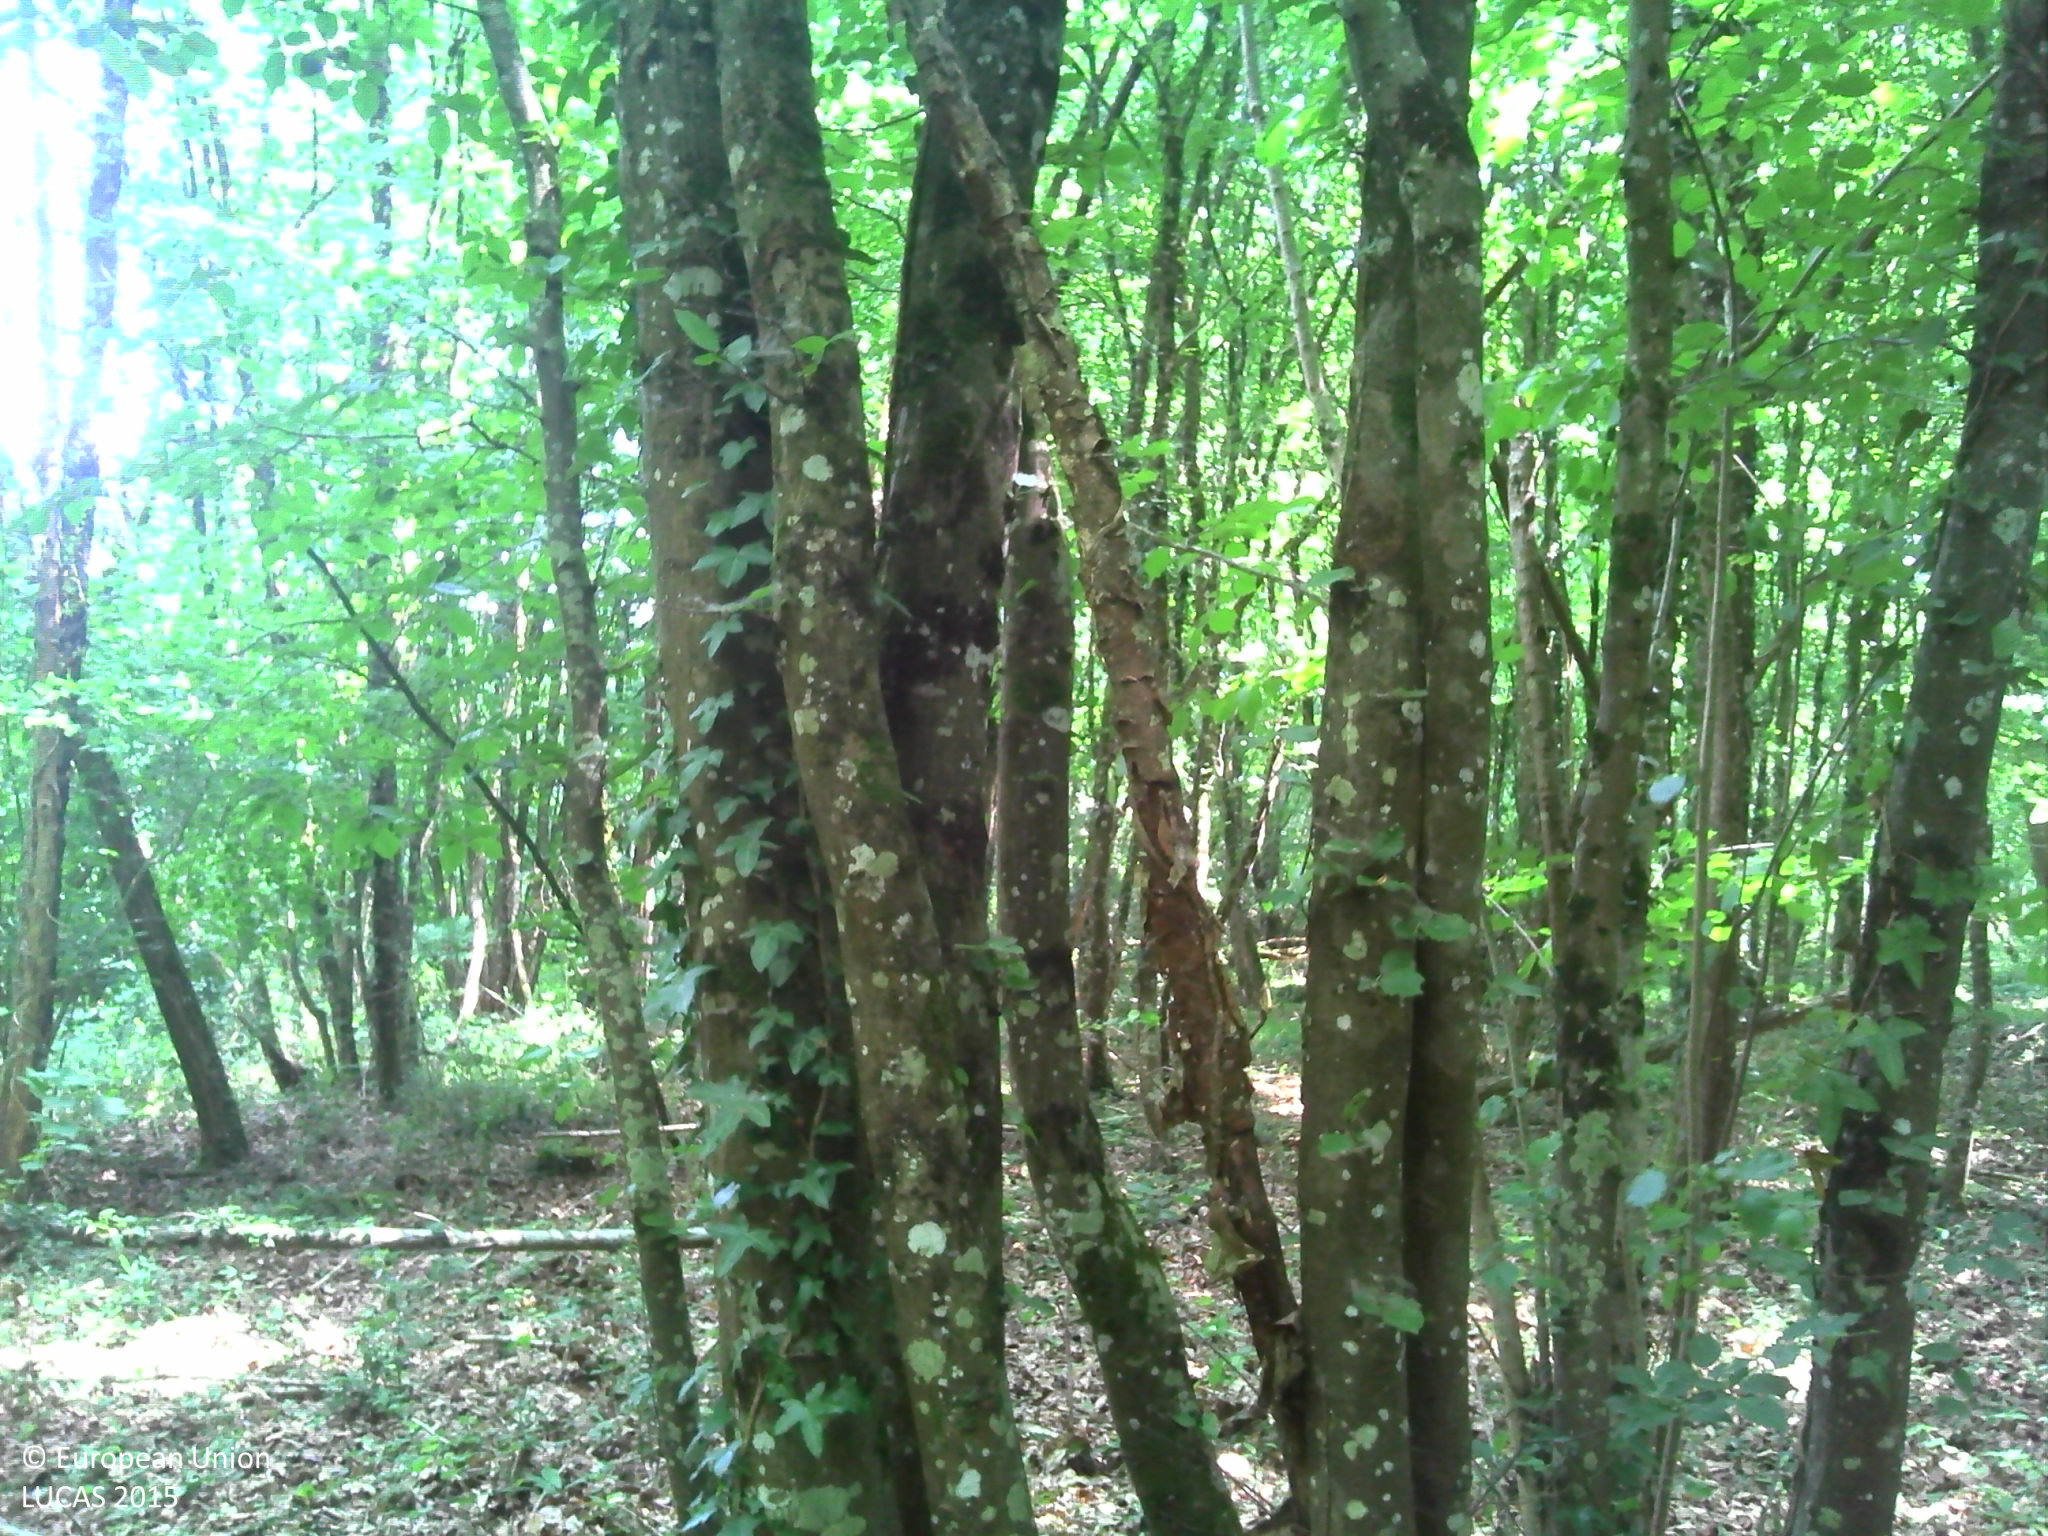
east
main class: Woodland
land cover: Broadleaved woodland
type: mesophytic deciduous forest
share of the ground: > 75 %
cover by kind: broadleaved forest trees 55 %, lichens and mosses 20 %, coniferous forest trees 15 %, herbaceous plants 10 %
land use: Forestry
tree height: > 5 m
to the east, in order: Broadleaved woodland; Dry stone walls; Grass margins; Ditches and canals; Grass margins; Paved roads, cycling and walking lanes; Grass margins; Ditches and canals; Managed hedges; Fences; Grassland without tree/shrub cover; Electric lines; Grassland without tree/shrub cover; Fences; Managed hedges; Ditches and canals; Grass margins; Paved roads, cycling and walking lanes; Grass margins; Ditches and canals; Maize; Abandoned hedges; Grass margins; Tracks; Grass margins; Abandoned hedges; Maize; Ditches and canals; Broadleaved woodland
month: June
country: FR
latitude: 47.7909
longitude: 0.0551
